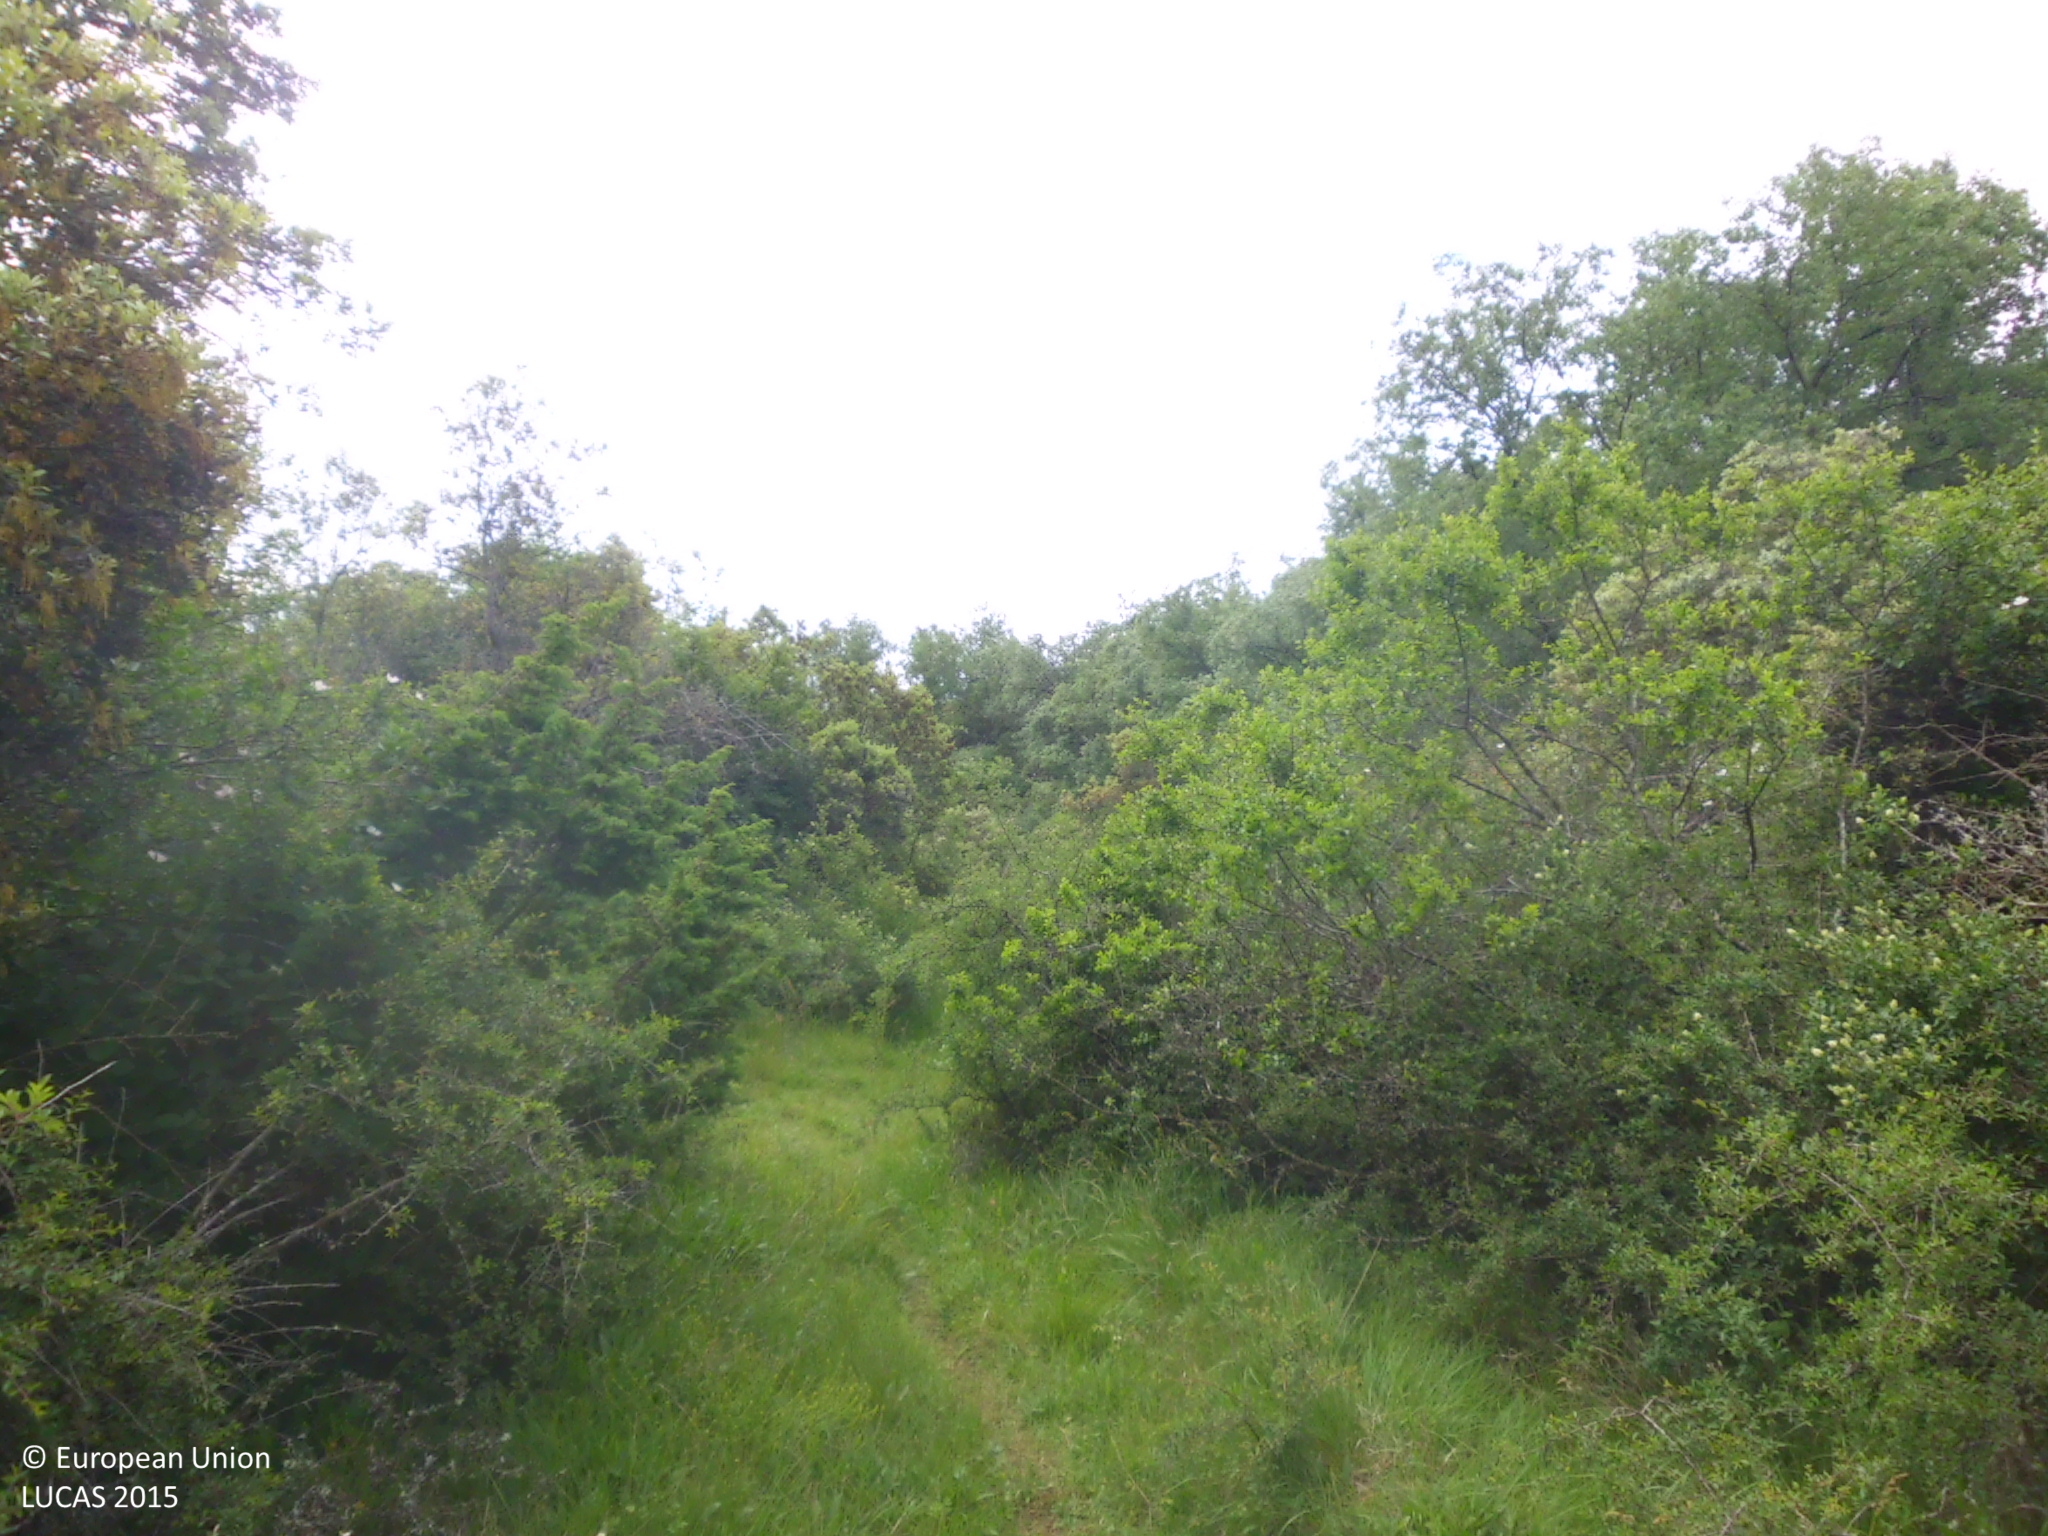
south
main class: Woodland
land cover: Broadleaved woodland
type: broadleaved evergreen forest
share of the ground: 50 - 75 %
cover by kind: broadleaved forest trees 50 %, shrubs 30 %, herbaceous plants 20 %
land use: Semi-natural and natural areas not in use
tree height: > 5 m
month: June
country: ES
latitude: 42.5075
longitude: -3.4084
